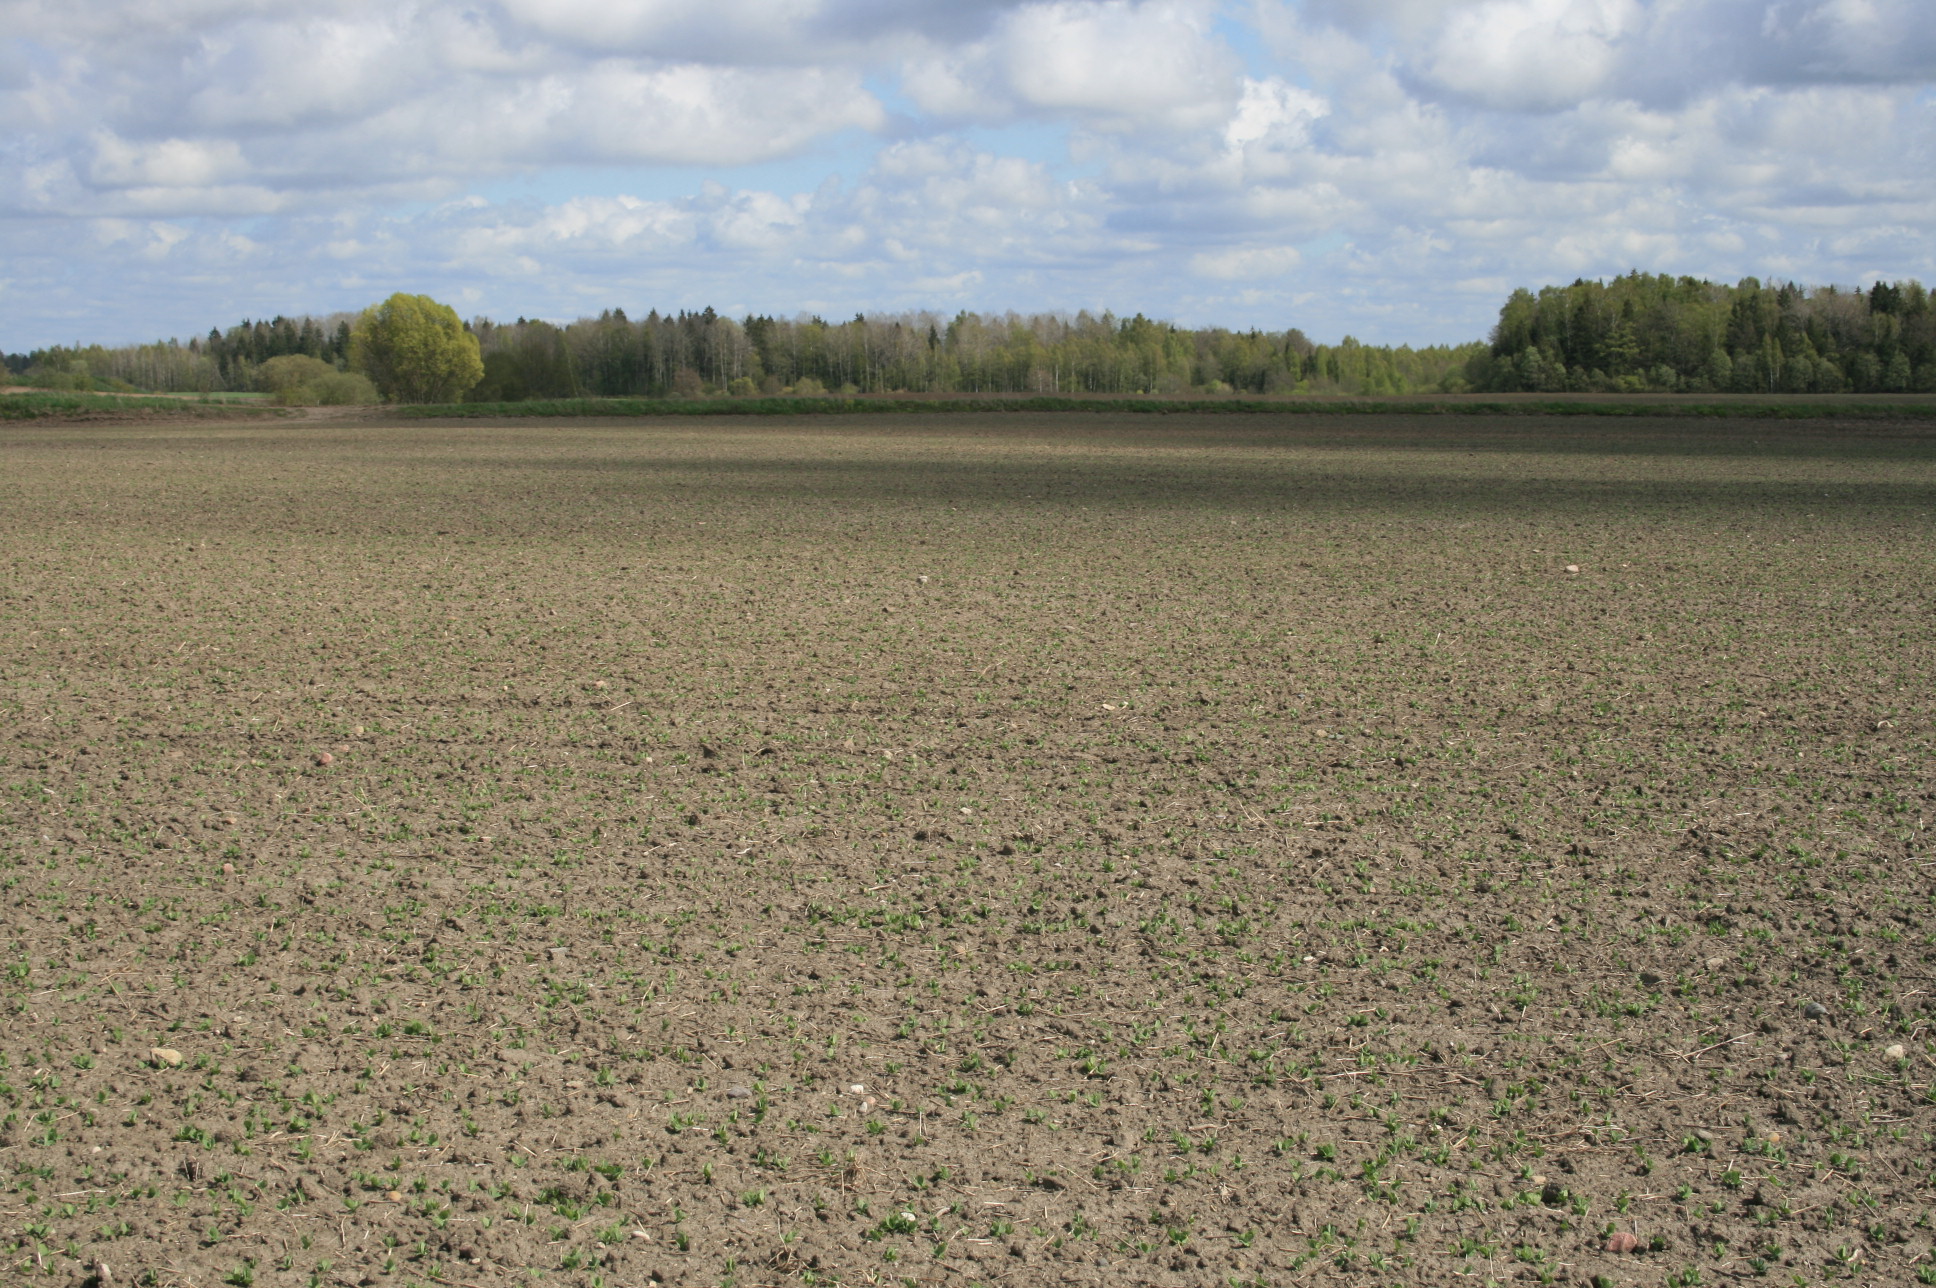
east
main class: Cropland
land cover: Dry pulses
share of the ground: 10 - 25 %
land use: Agriculture (excluding fallow land and kitchen gardens)
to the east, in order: Dry pulses; Grass margins; Tracks; Grass margins; Ditches and canals; Common wheat; Spontaneously vegetated surfaces
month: May
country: LT
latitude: 56.1690
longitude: 21.3962
